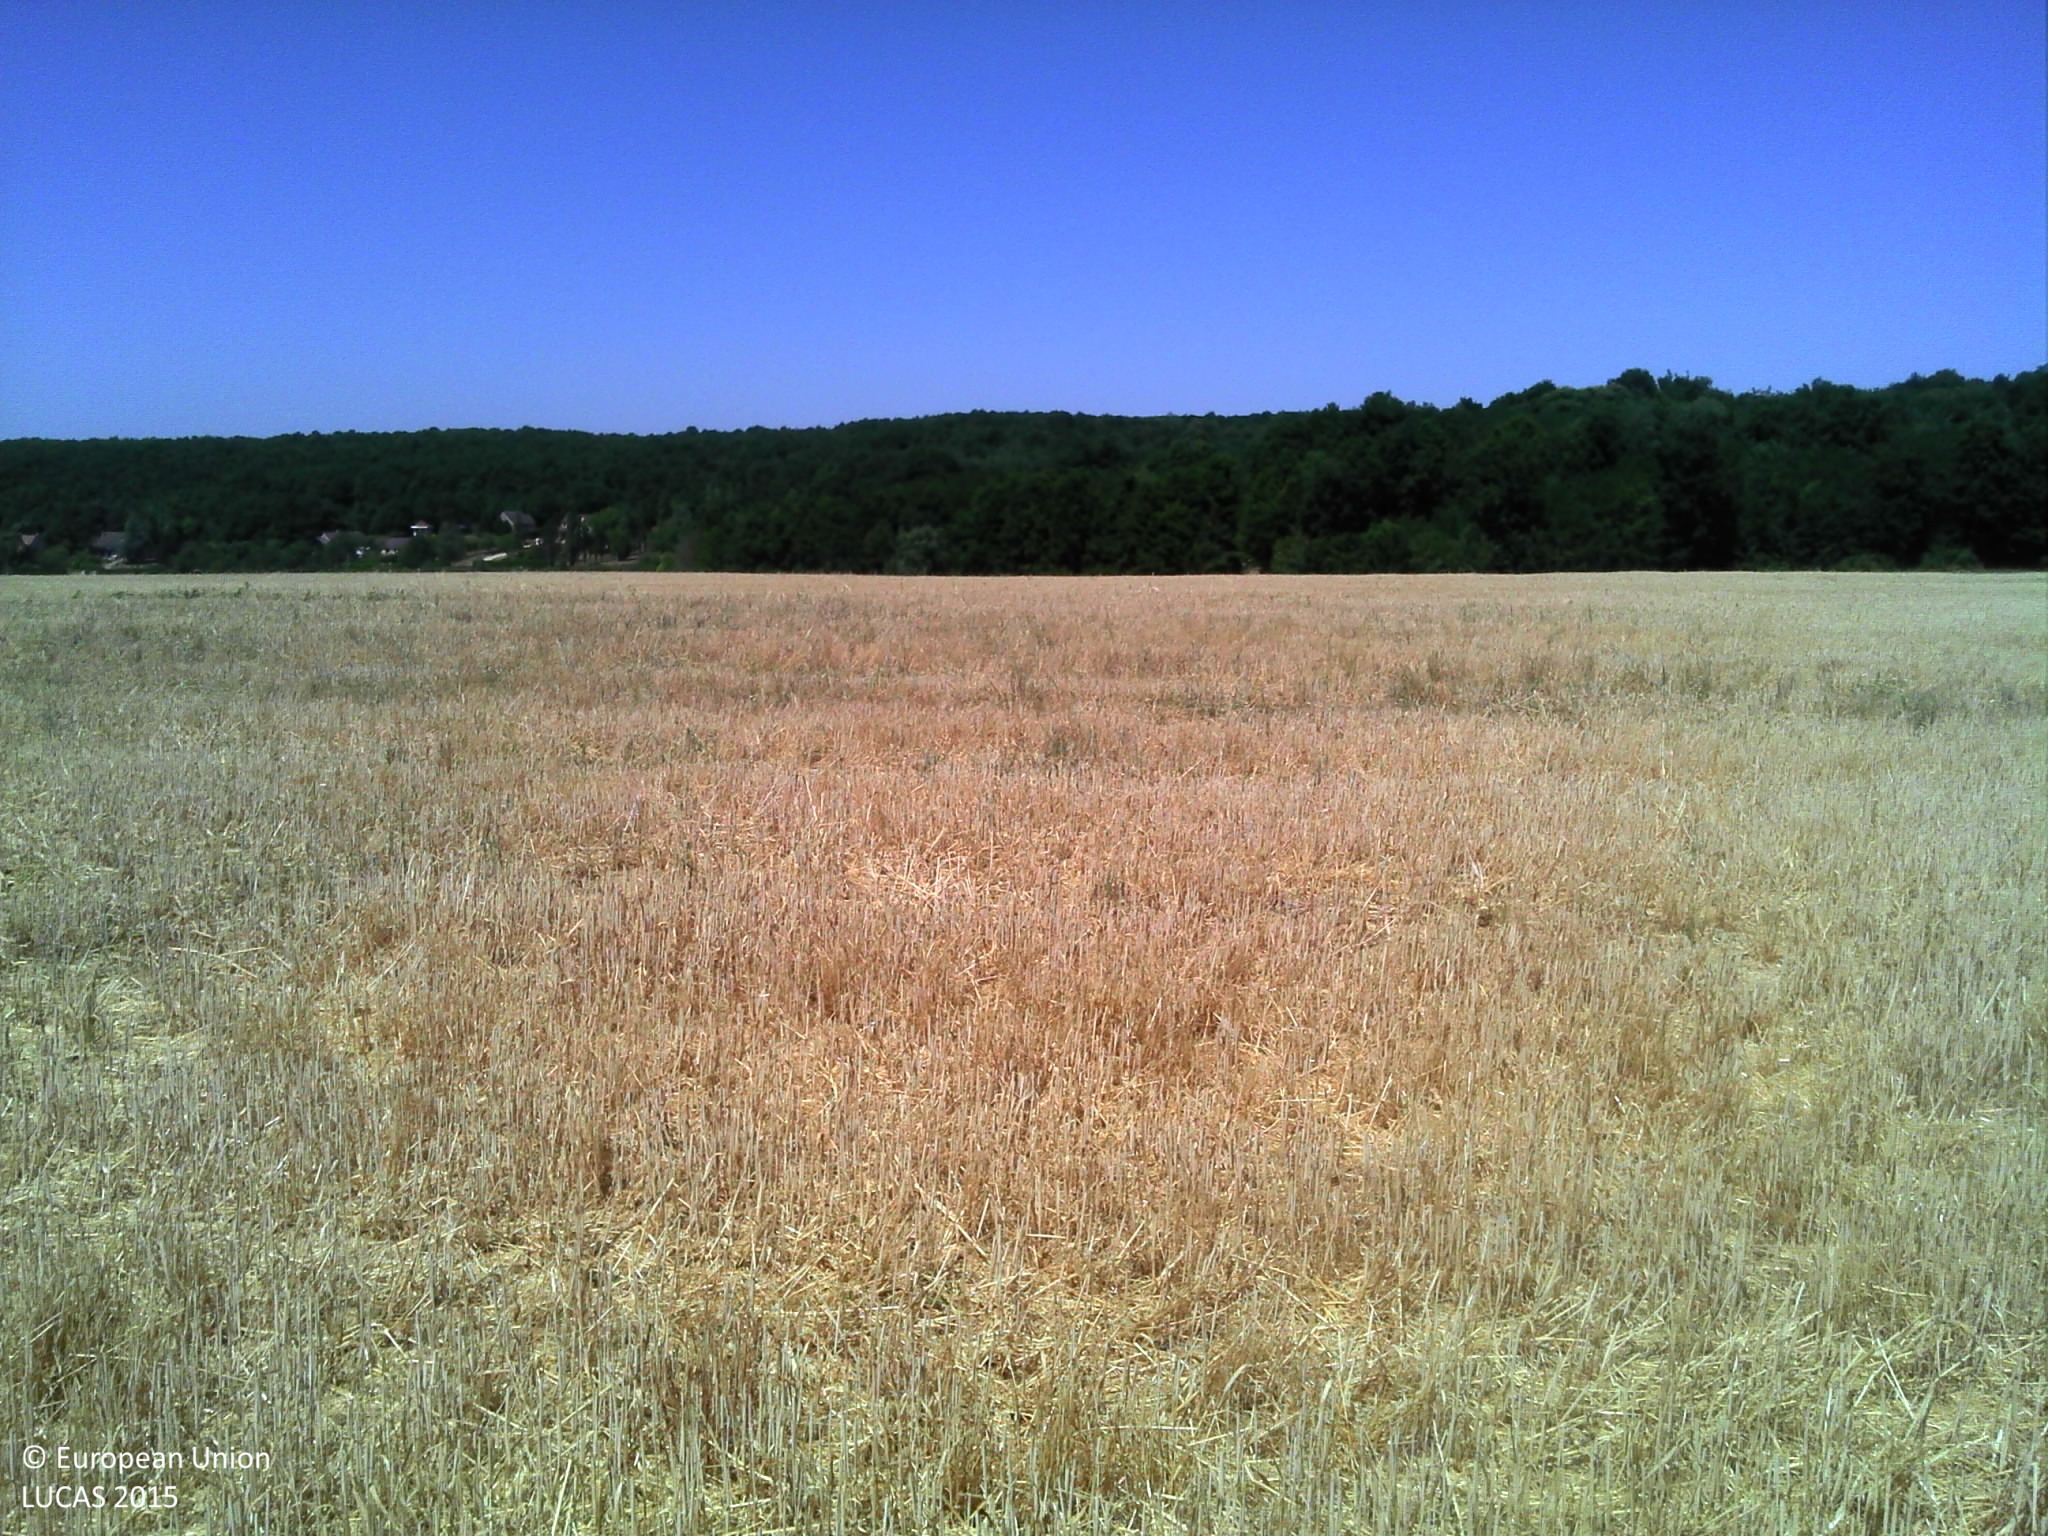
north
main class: Cropland
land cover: Barley
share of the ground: > 75 %
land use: Agriculture (excluding fallow land and kitchen gardens)
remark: Harvested field
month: July
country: FR
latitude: 48.2948
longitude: 3.0777
